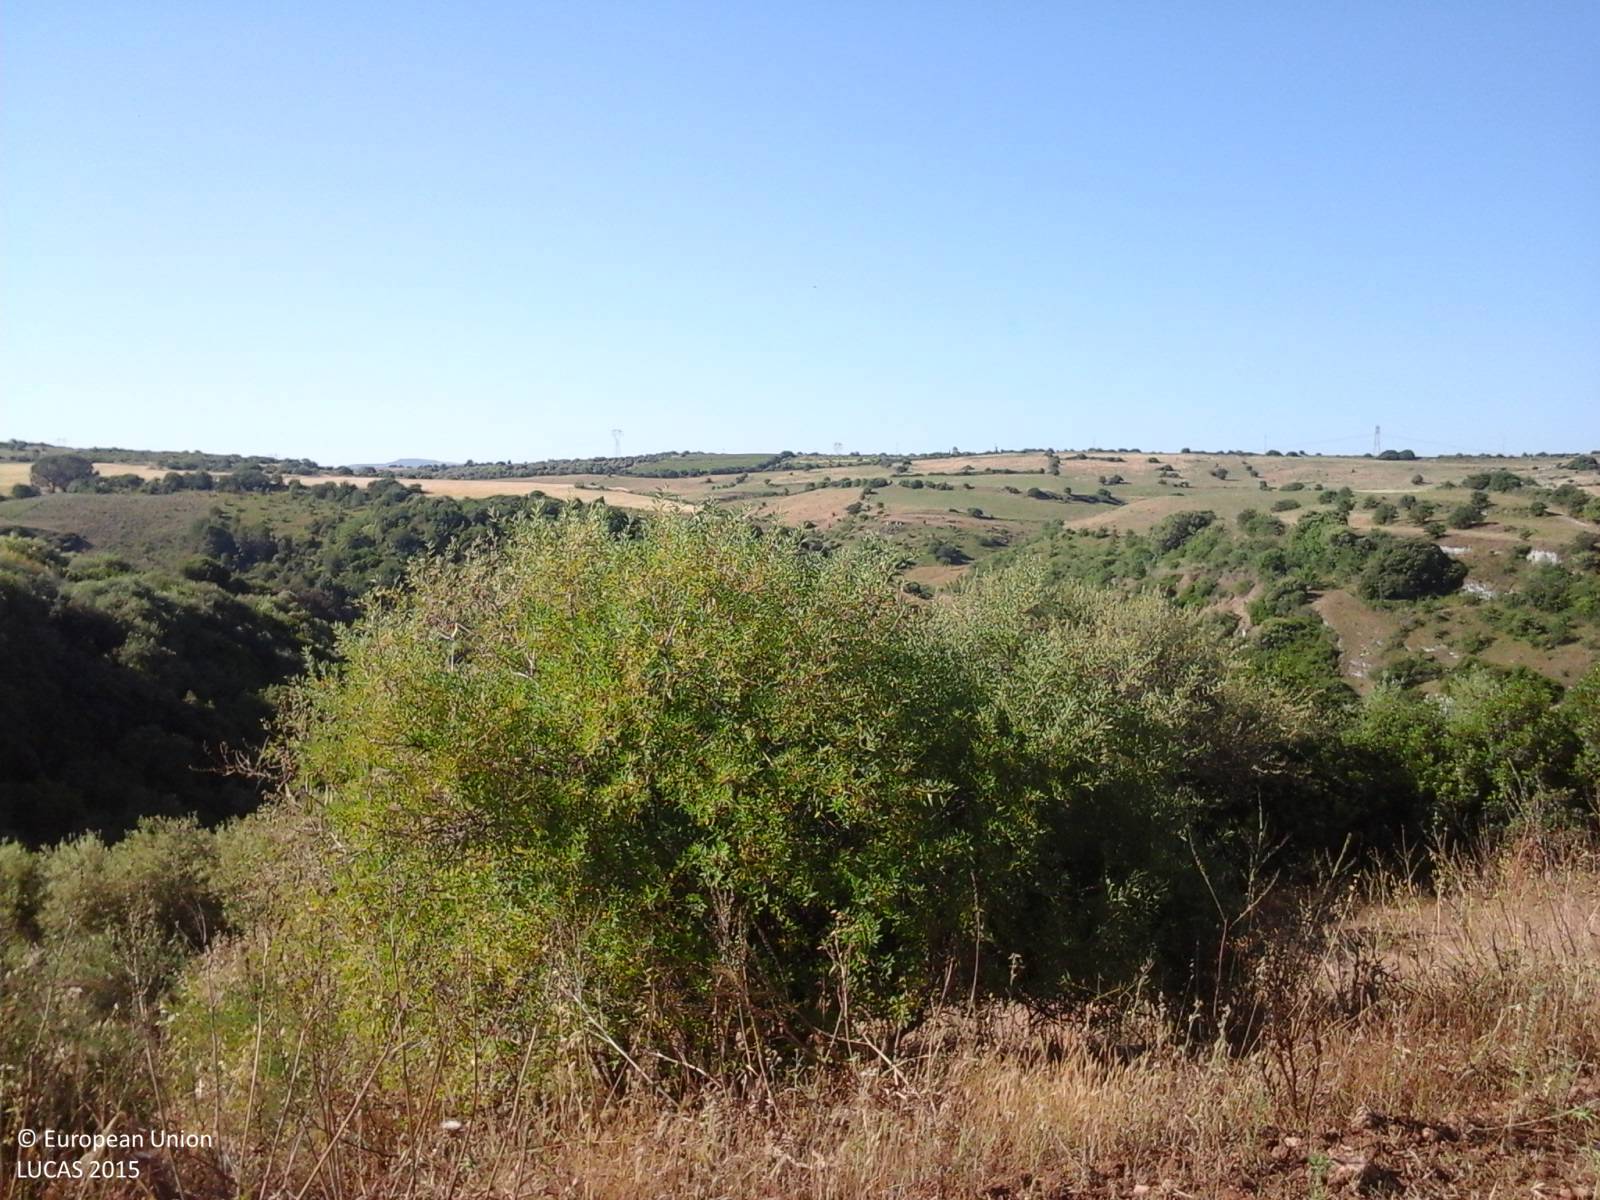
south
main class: Grassland
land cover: Grassland without tree/shrub cover
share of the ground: > 75 %
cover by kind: herbaceous plants 50 %
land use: Agriculture (excluding fallow land and kitchen gardens)
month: May
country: IT
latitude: 40.6900
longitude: 8.4809
